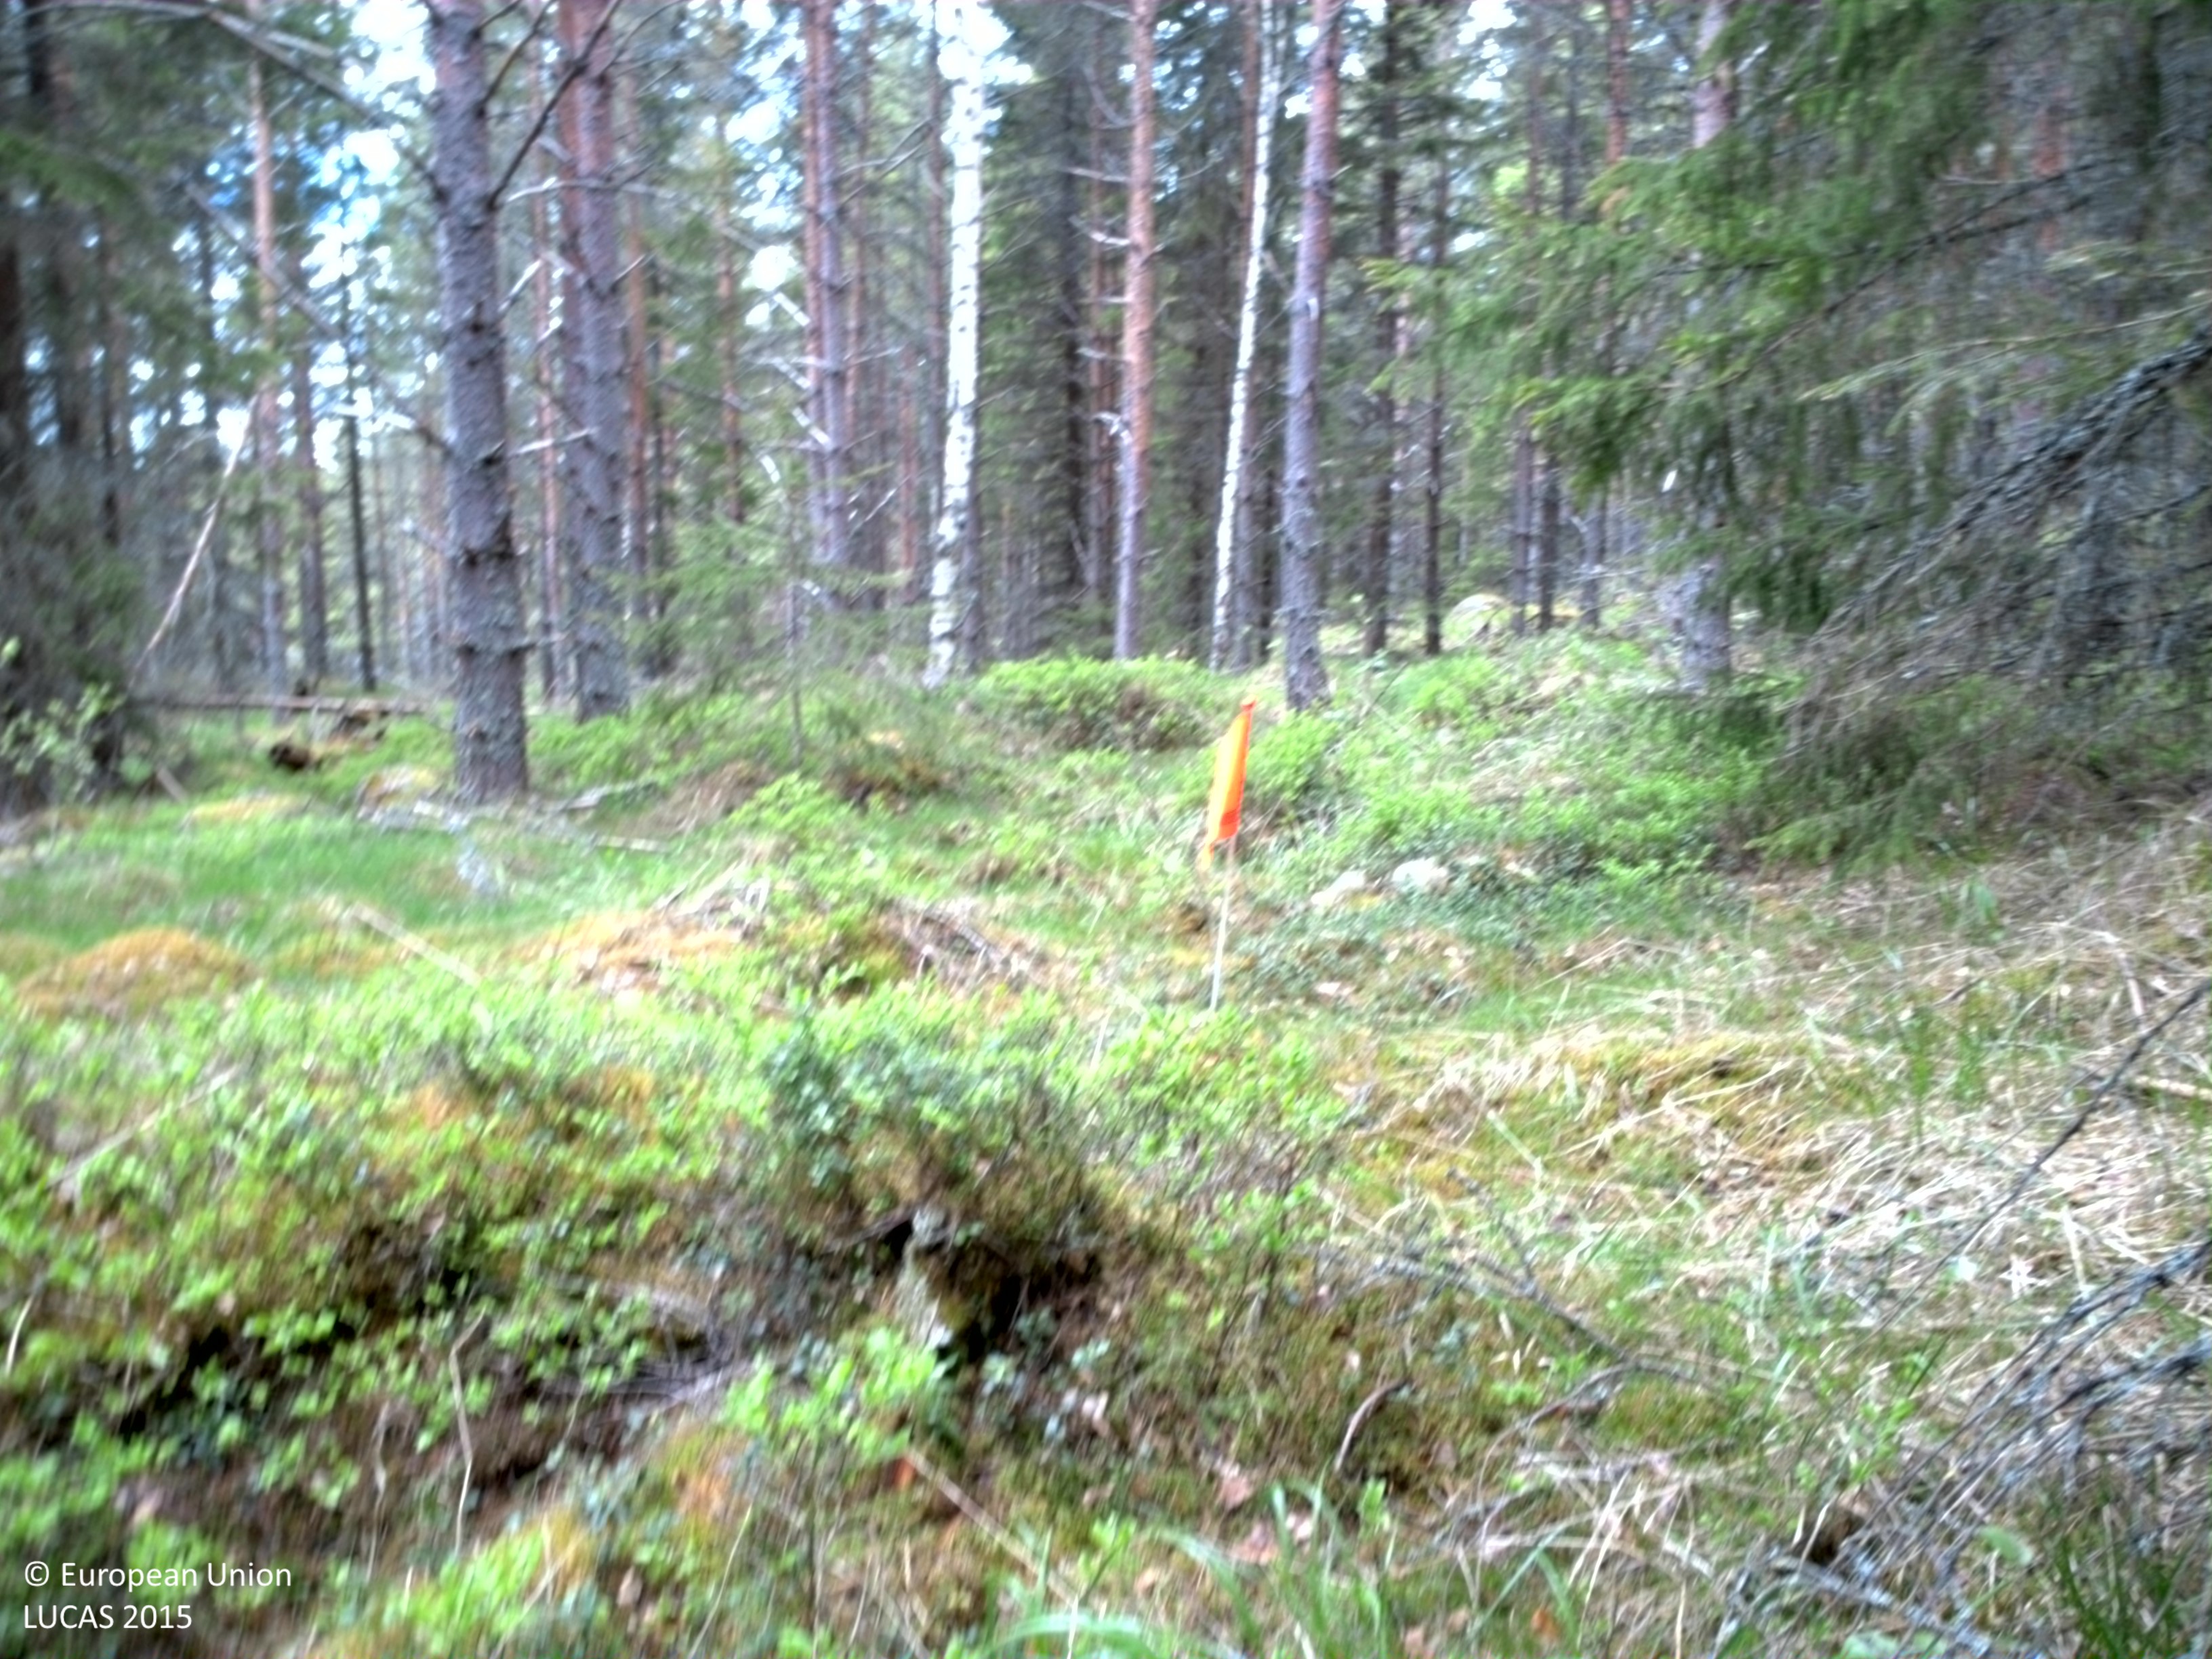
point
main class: Woodland
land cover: Pine dominated coniferous woodland
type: boreal forest
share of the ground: 50 - 75 %
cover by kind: coniferous forest trees 65 %, herbaceous plants 30 %, lichens and mosses 5 %
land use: Forestry
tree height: > 5 m
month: May
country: SE
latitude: 61.2822
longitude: 15.5258
